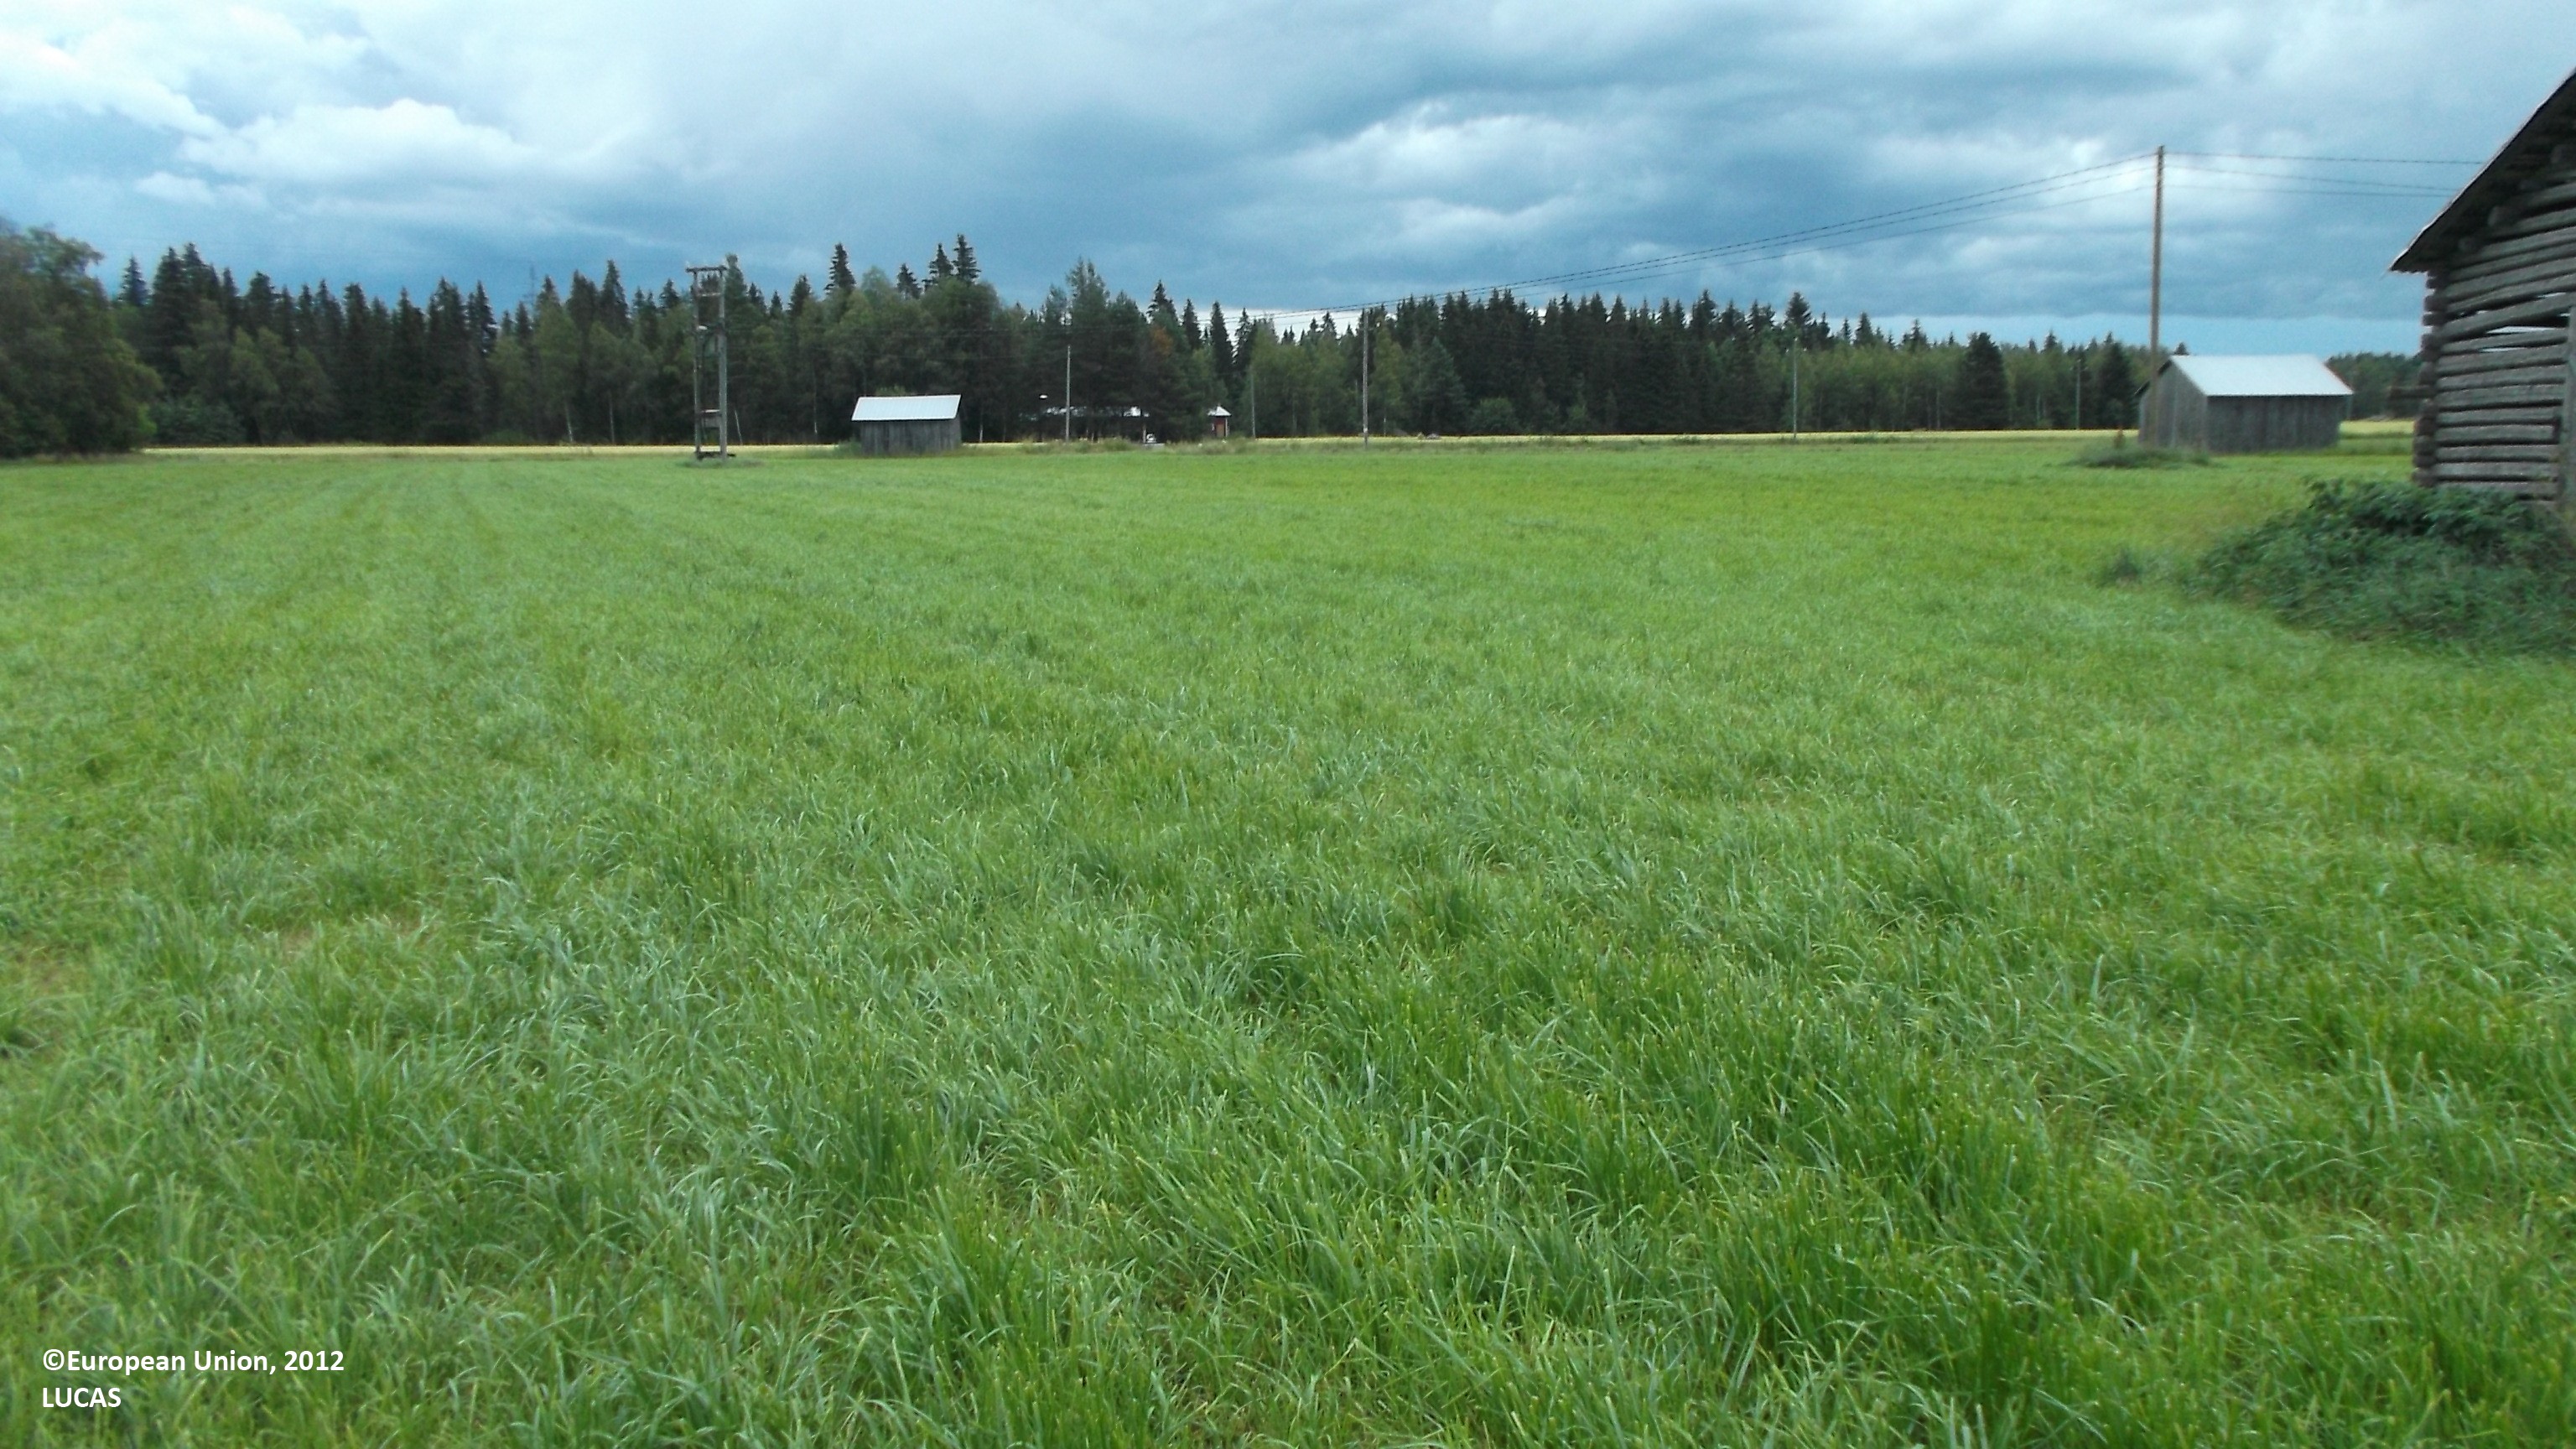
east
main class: Cropland
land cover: Temporary grasslands
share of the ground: > 75 %
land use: Agriculture (excluding fallow land and kitchen gardens)
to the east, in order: Temporary grasslands; Paved roads, cycling and walking lanes; Ditches and canals; Temporary grasslands; Ditches and canals; Grass margins; Paved roads, cycling and walking lanes; Grass margins; Ditches and canals; Spontaneously vegetated surfaces; Ditches and canals; Fences; Pine dominated coniferous woodland; Grassland with sparse tree/shrub cover; Artificial constructions in urban areas; Grassland without tree/shrub cover; Other mixed woodland; Grassland with sparse tree/shrub cover
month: August
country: FI
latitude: 64.0379
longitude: 23.5079
